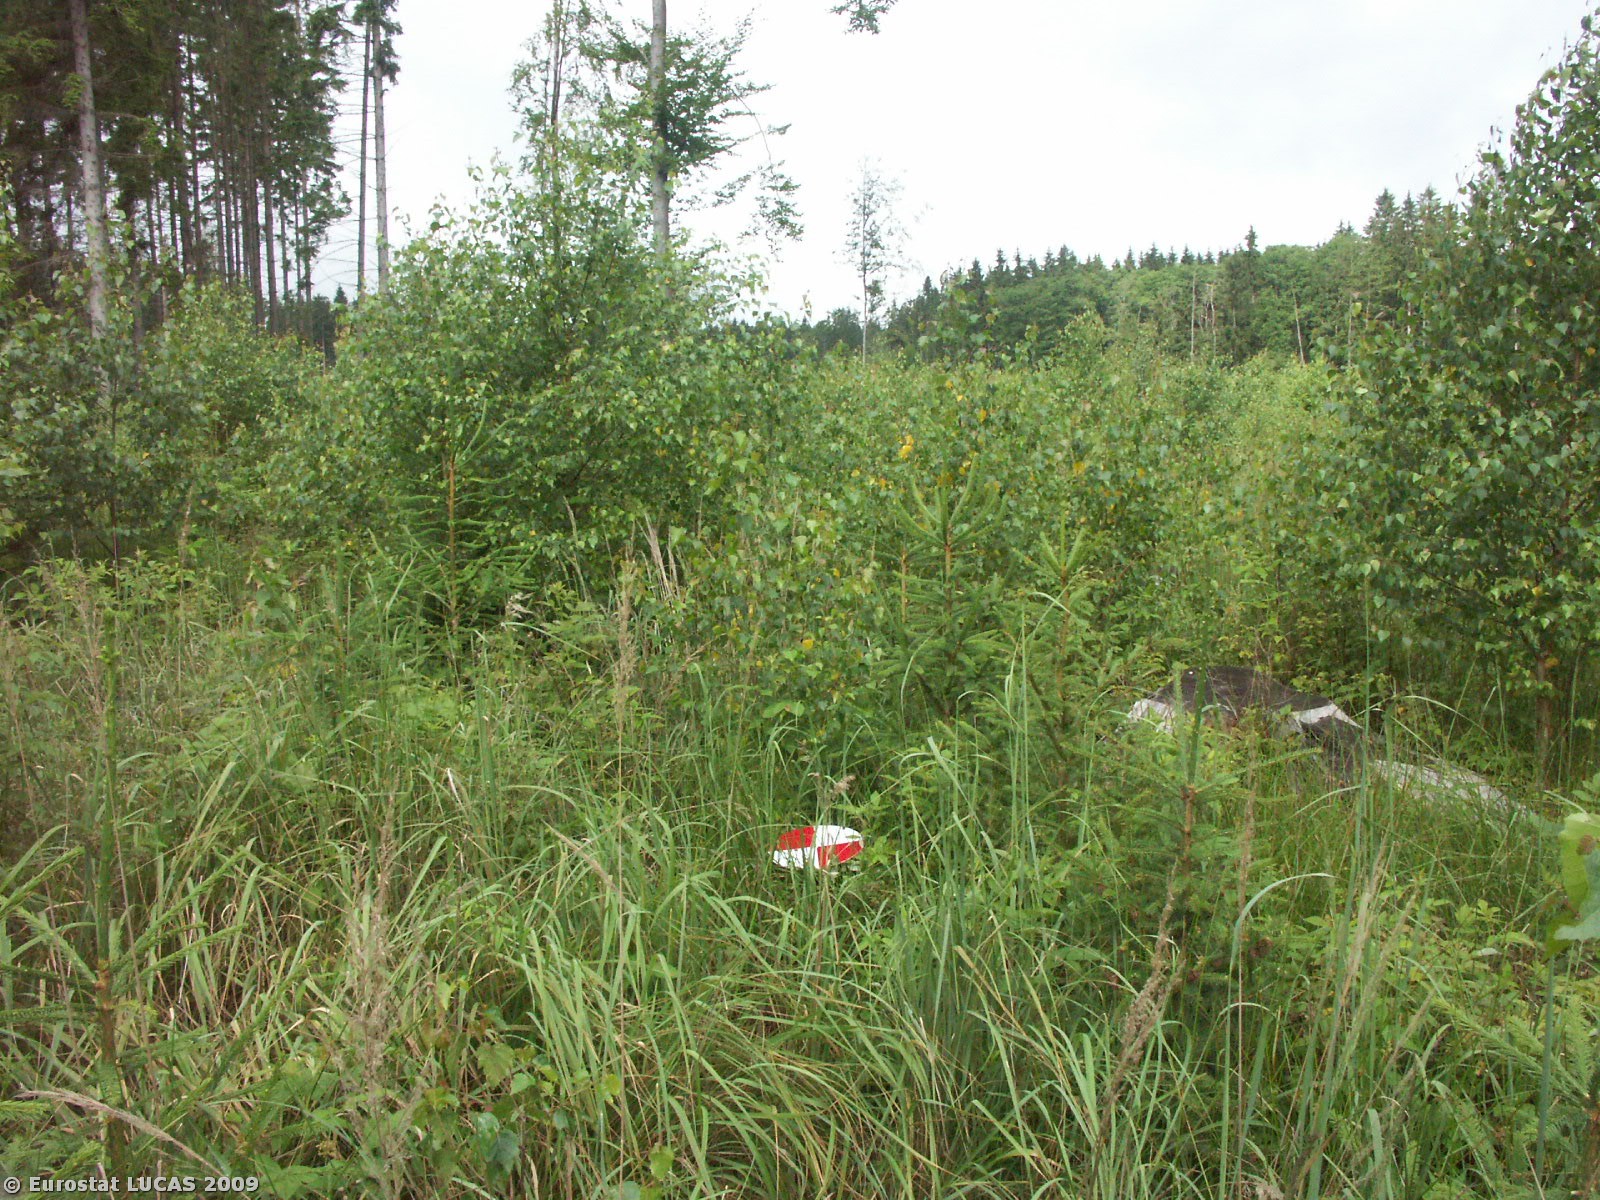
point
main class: Woodland
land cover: Mixed woodland
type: hemiboreal forest and nemoral coniferous forest and mixed broadleaved-coniferous forest
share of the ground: > 75 %
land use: Forestry
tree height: > 5 m
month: July
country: CZ
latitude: 49.9035
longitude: 17.4610
